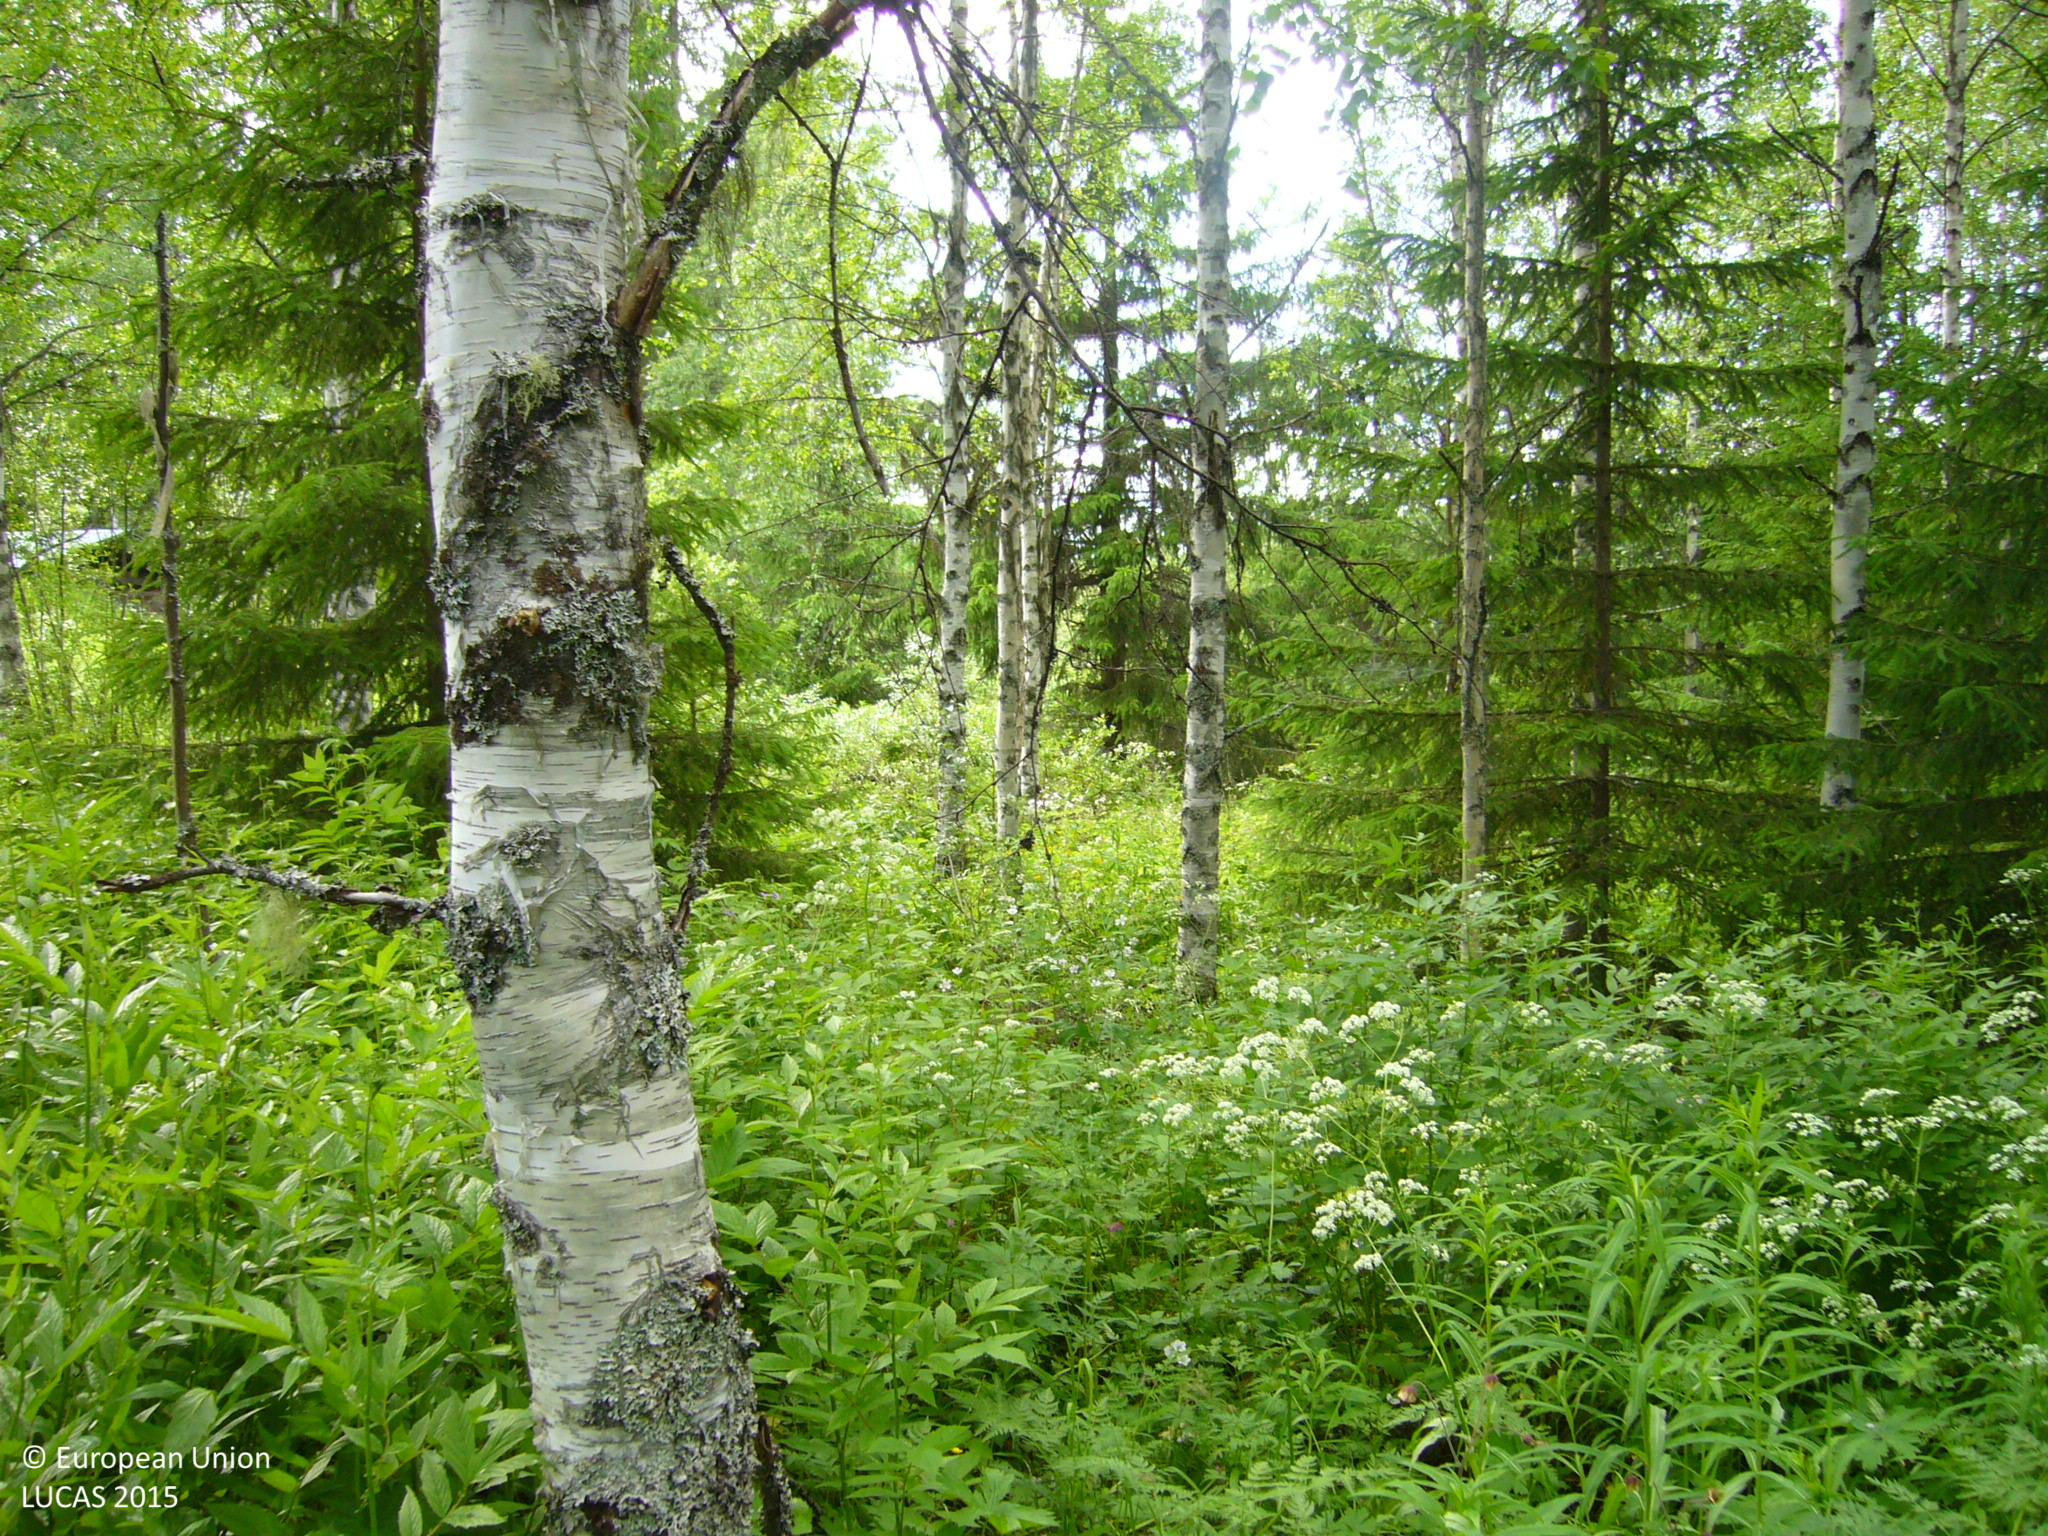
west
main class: Woodland
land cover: Spruce dominated mixed woodland
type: boreal forest
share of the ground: 50 - 75 %
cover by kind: broadleaved forest trees 40 %, coniferous forest trees 30 %, herbaceous plants 30 %
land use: Forestry
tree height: > 5 m
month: July
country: FI
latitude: 63.5397
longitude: 26.1904
